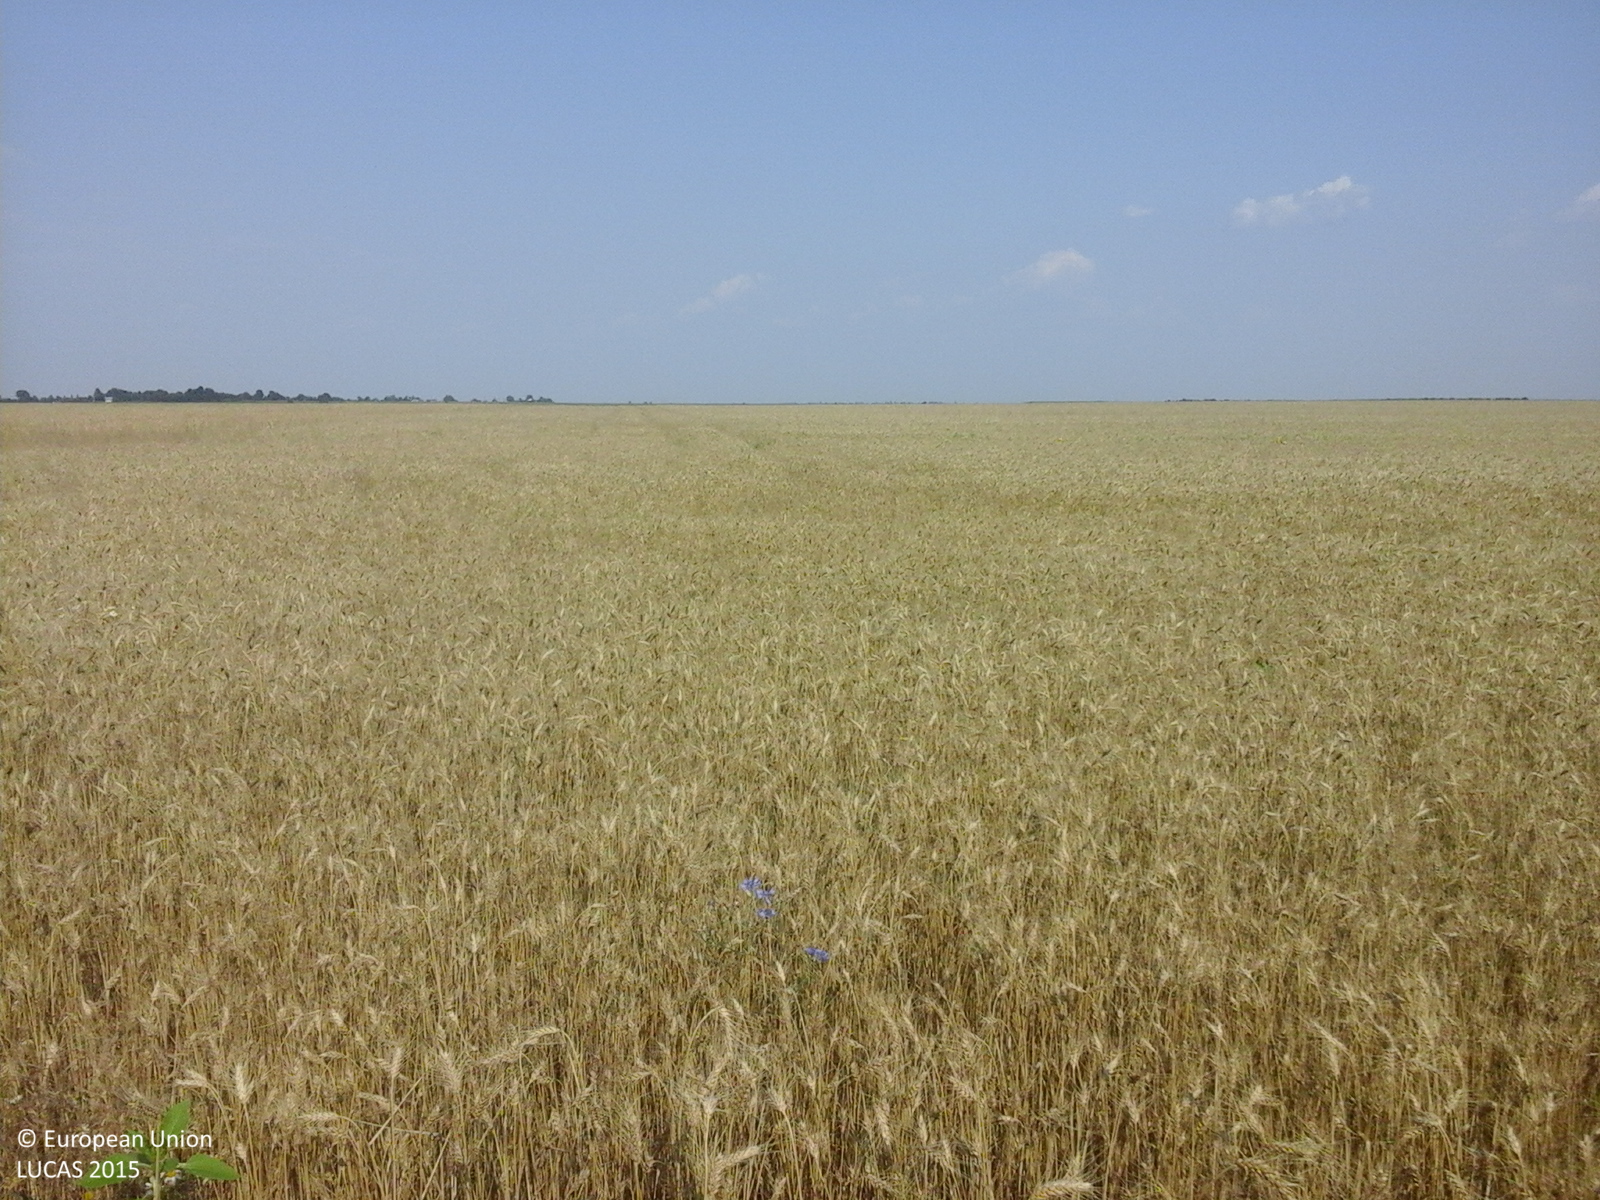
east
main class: Cropland
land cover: Common wheat
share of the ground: > 75 %
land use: Agriculture (excluding fallow land and kitchen gardens)
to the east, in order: Common wheat
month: July
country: RO
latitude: 44.6490
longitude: 24.9732
